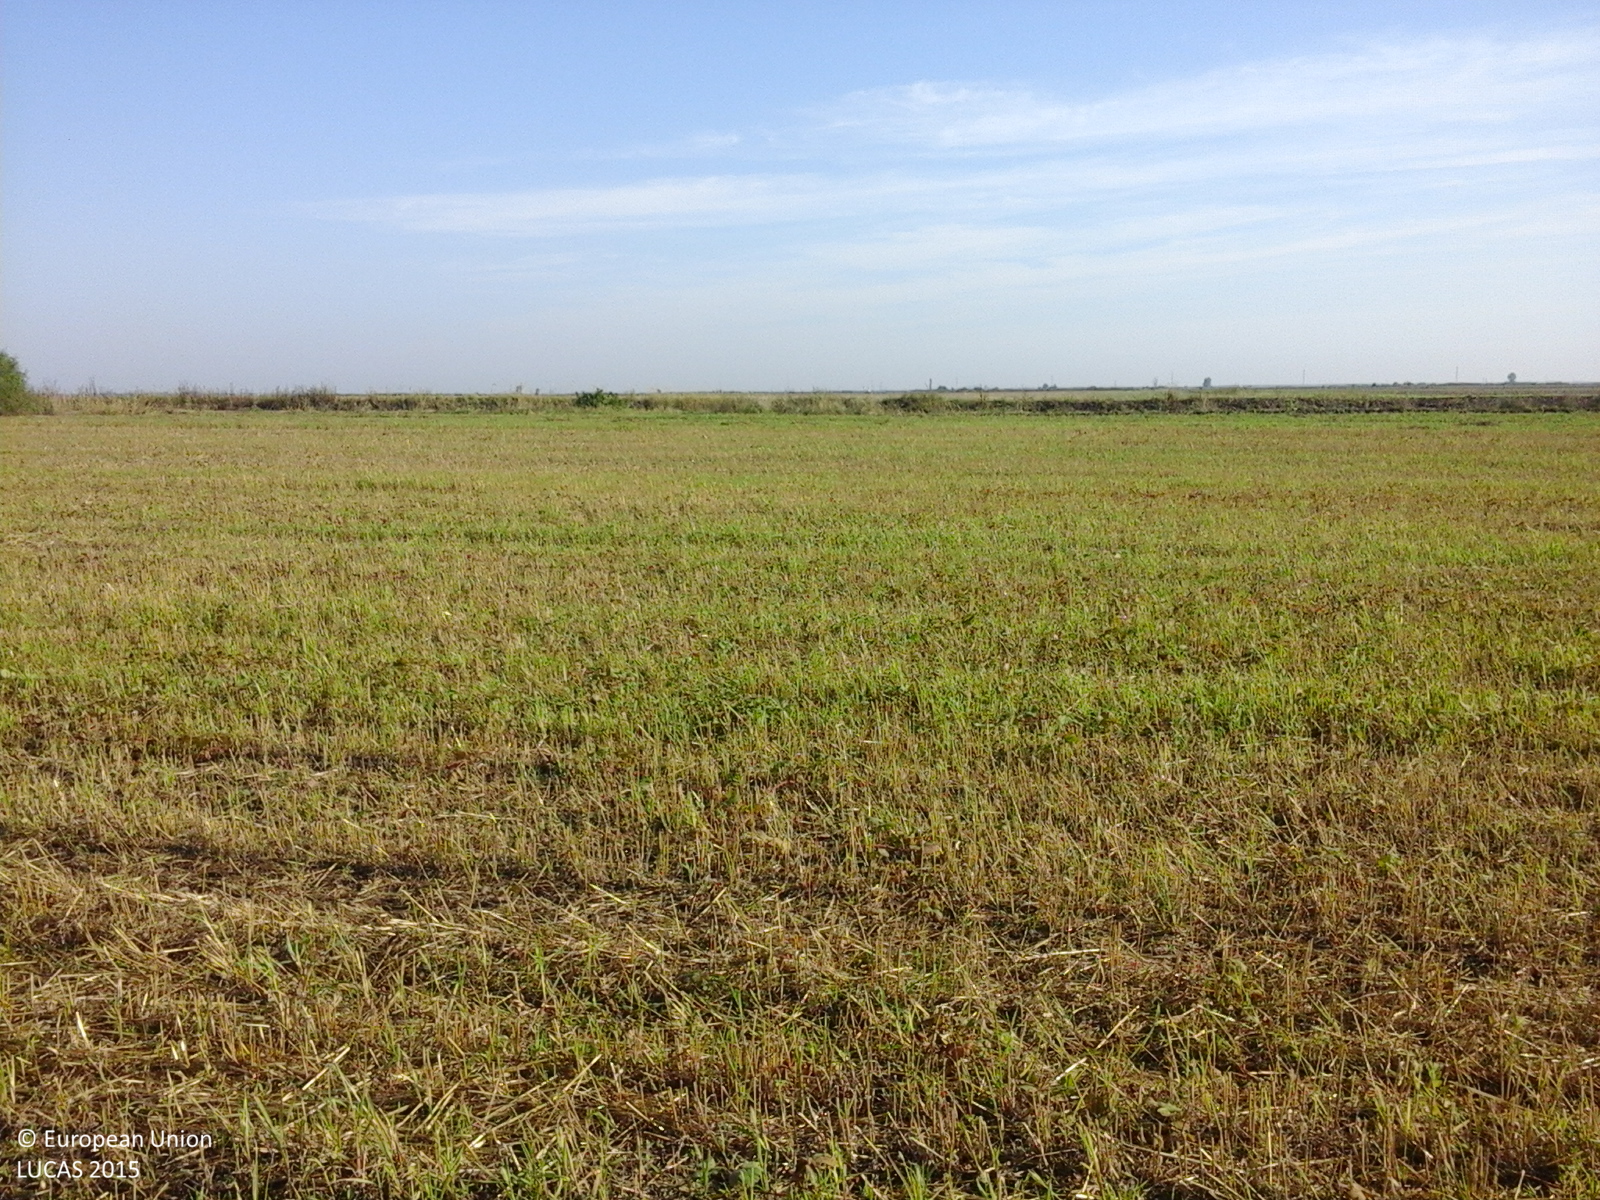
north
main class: Cropland
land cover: Durum wheat
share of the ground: 25 - 50 %
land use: Agriculture (excluding fallow land and kitchen gardens)
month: August
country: RO
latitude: 45.7865
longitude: 21.1305
